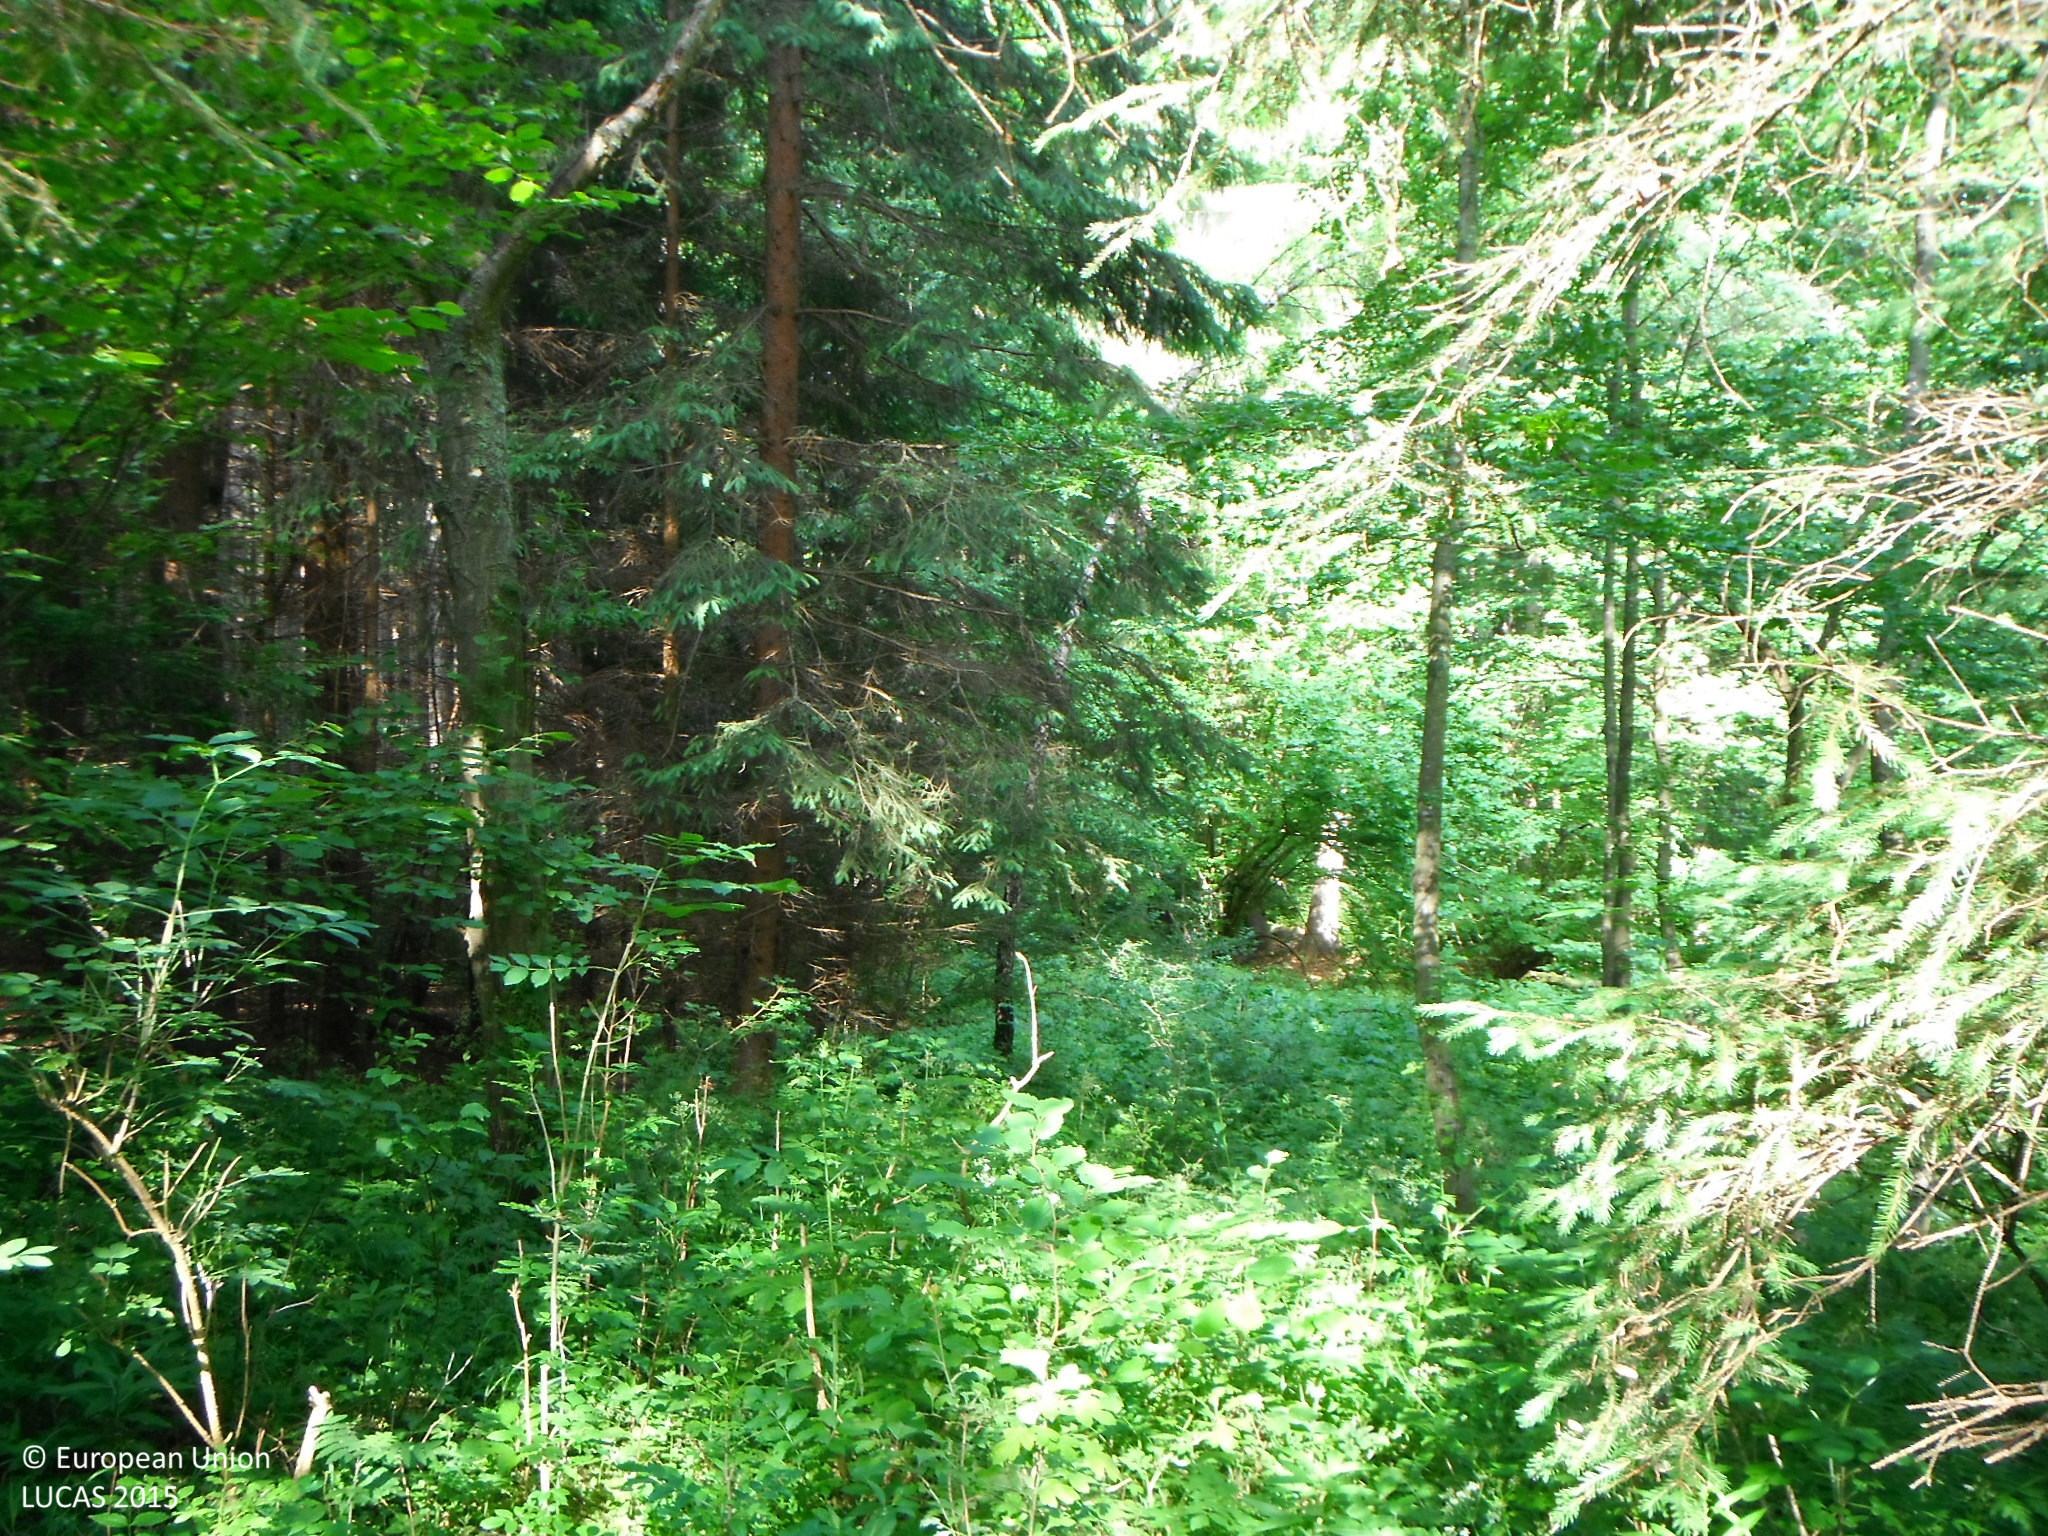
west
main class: Woodland
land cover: Spruce dominated mixed woodland
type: hemiboreal forest and nemoral coniferous forest and mixed broadleaved-coniferous forest
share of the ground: > 75 %
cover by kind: coniferous forest trees 50 %, broadleaved forest trees 50 %
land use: Forestry
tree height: > 5 m
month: July
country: SK
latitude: 49.2736
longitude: 19.3576
